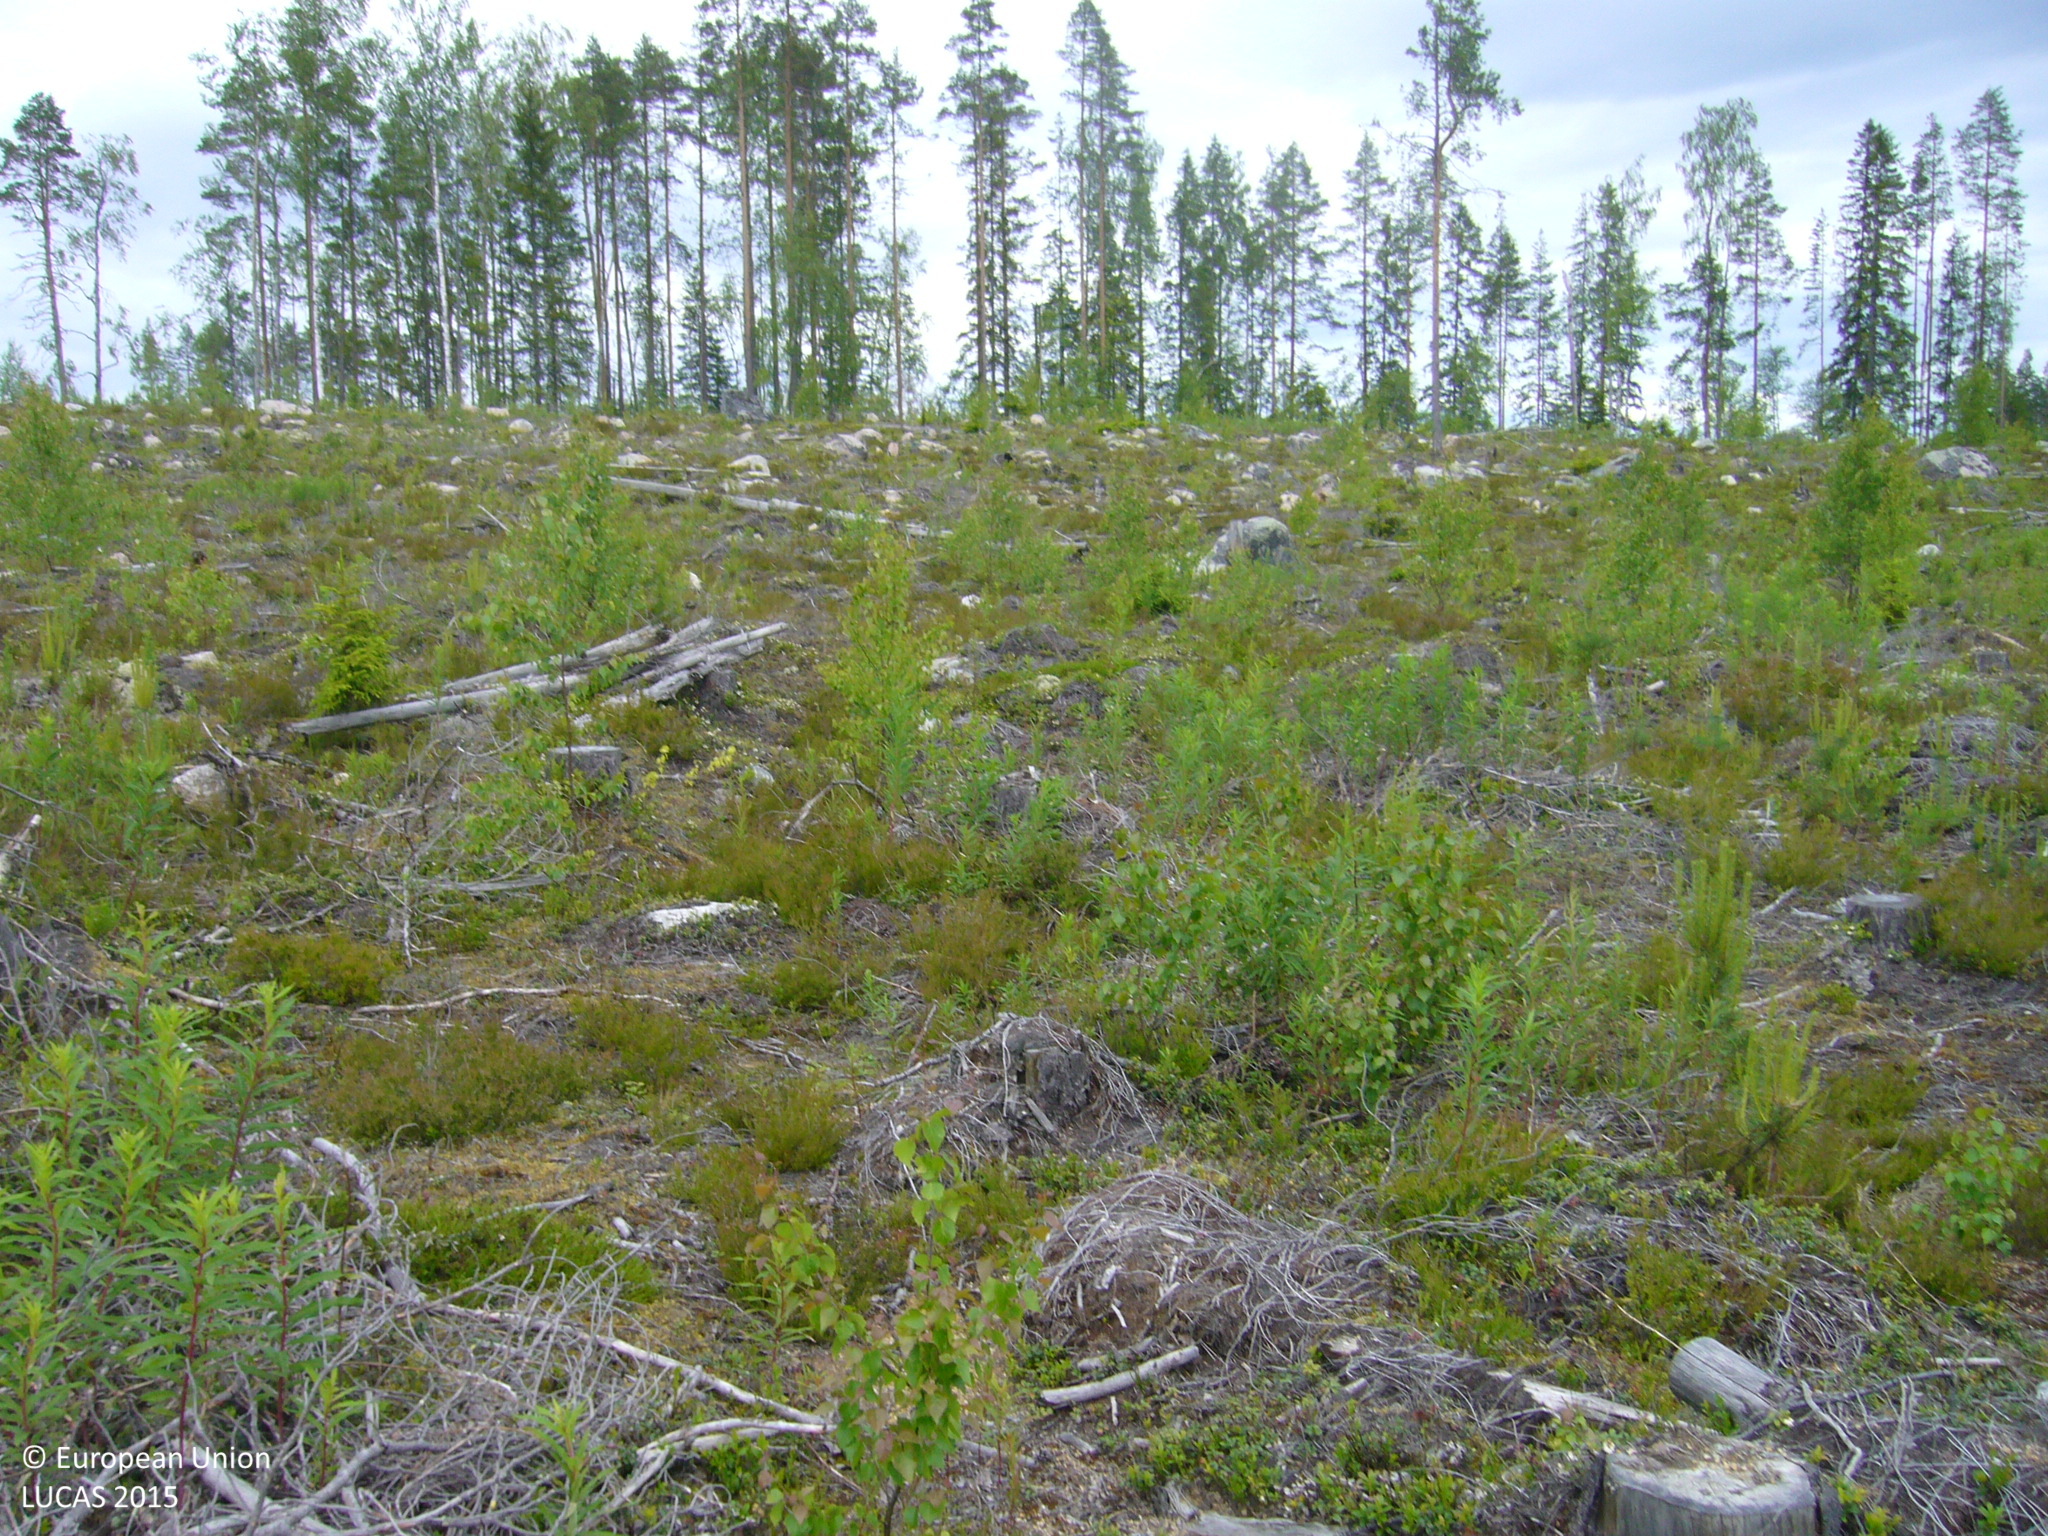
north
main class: Shrubland
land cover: Shrubland with sparse tree cover
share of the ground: > 75 %
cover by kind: shrubs 85 %, broadleaved forest trees 5 %
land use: Forestry
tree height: < 5 m
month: July
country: FI
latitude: 63.4133
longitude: 26.1604
